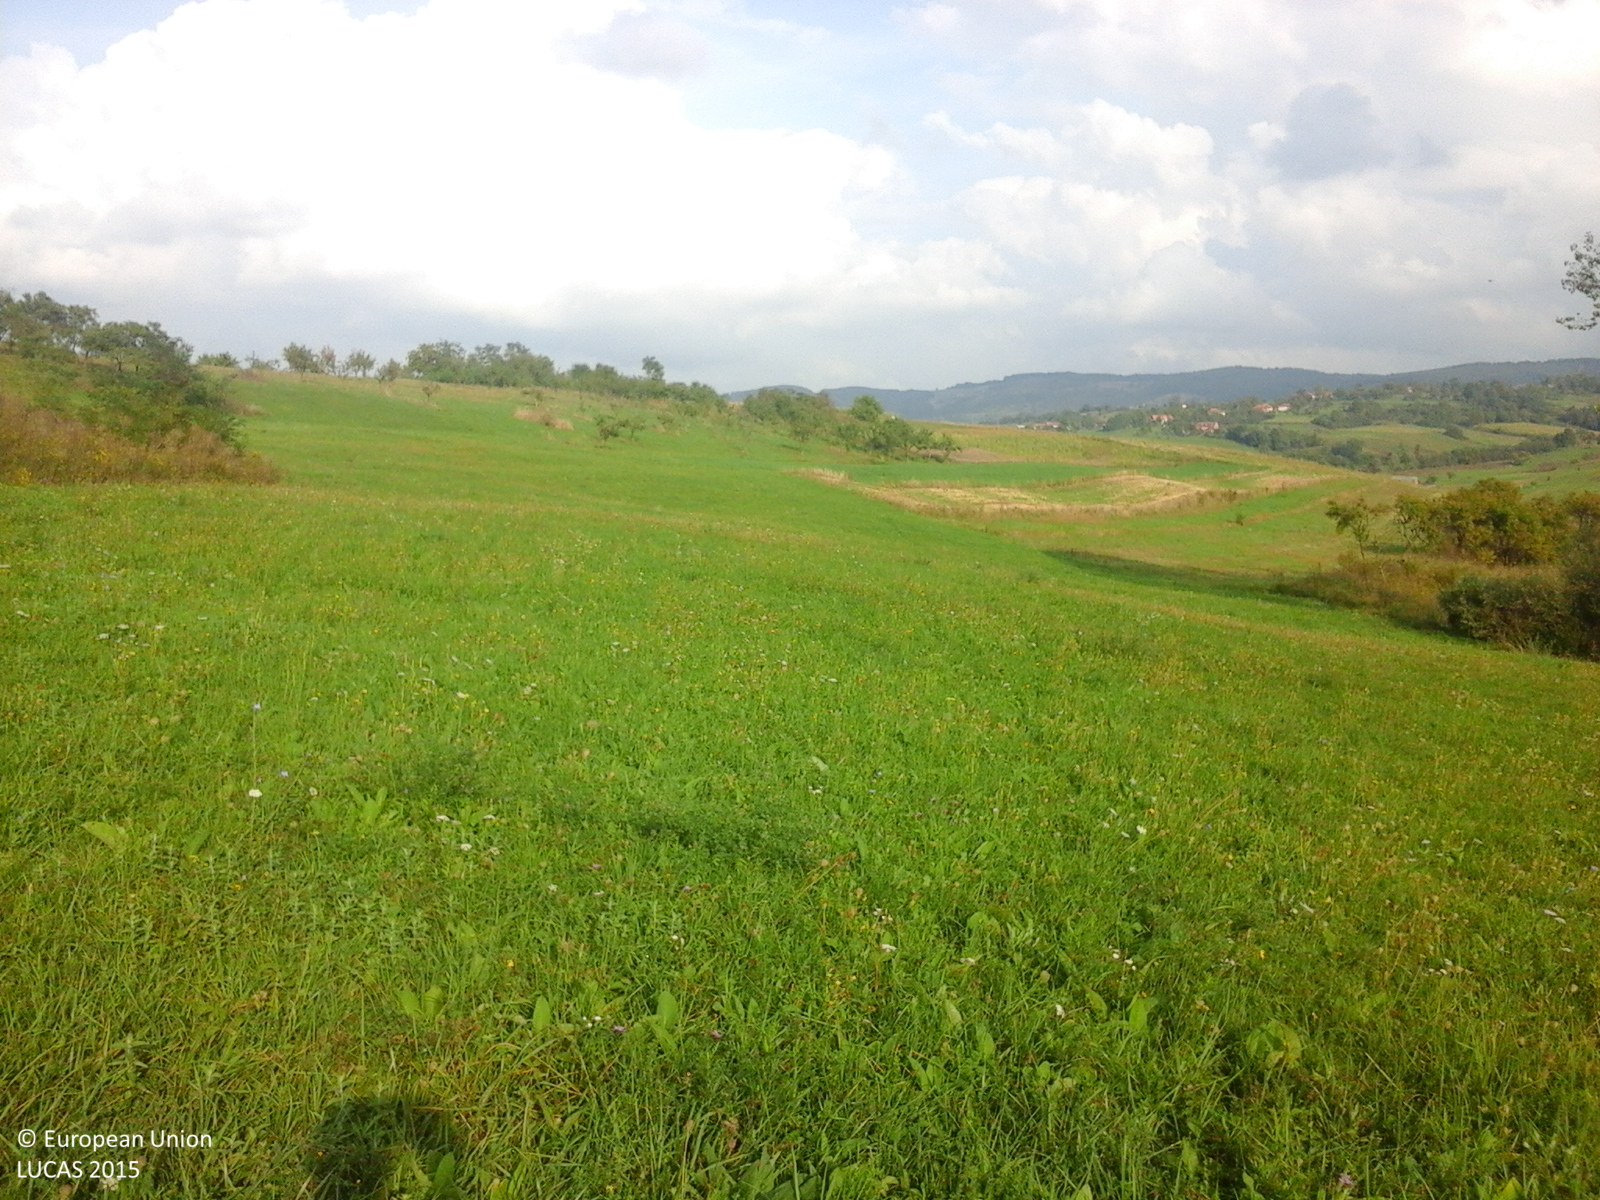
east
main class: Cropland
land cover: Other leguminous and mixtures for fodder
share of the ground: > 75 %
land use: Agriculture (excluding fallow land and kitchen gardens)
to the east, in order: Other leguminous and mixtures for fodder; Common wheat; Lucerne; Other fruit trees and berries; Maize
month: September
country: RO
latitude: 46.9504
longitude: 22.6033
